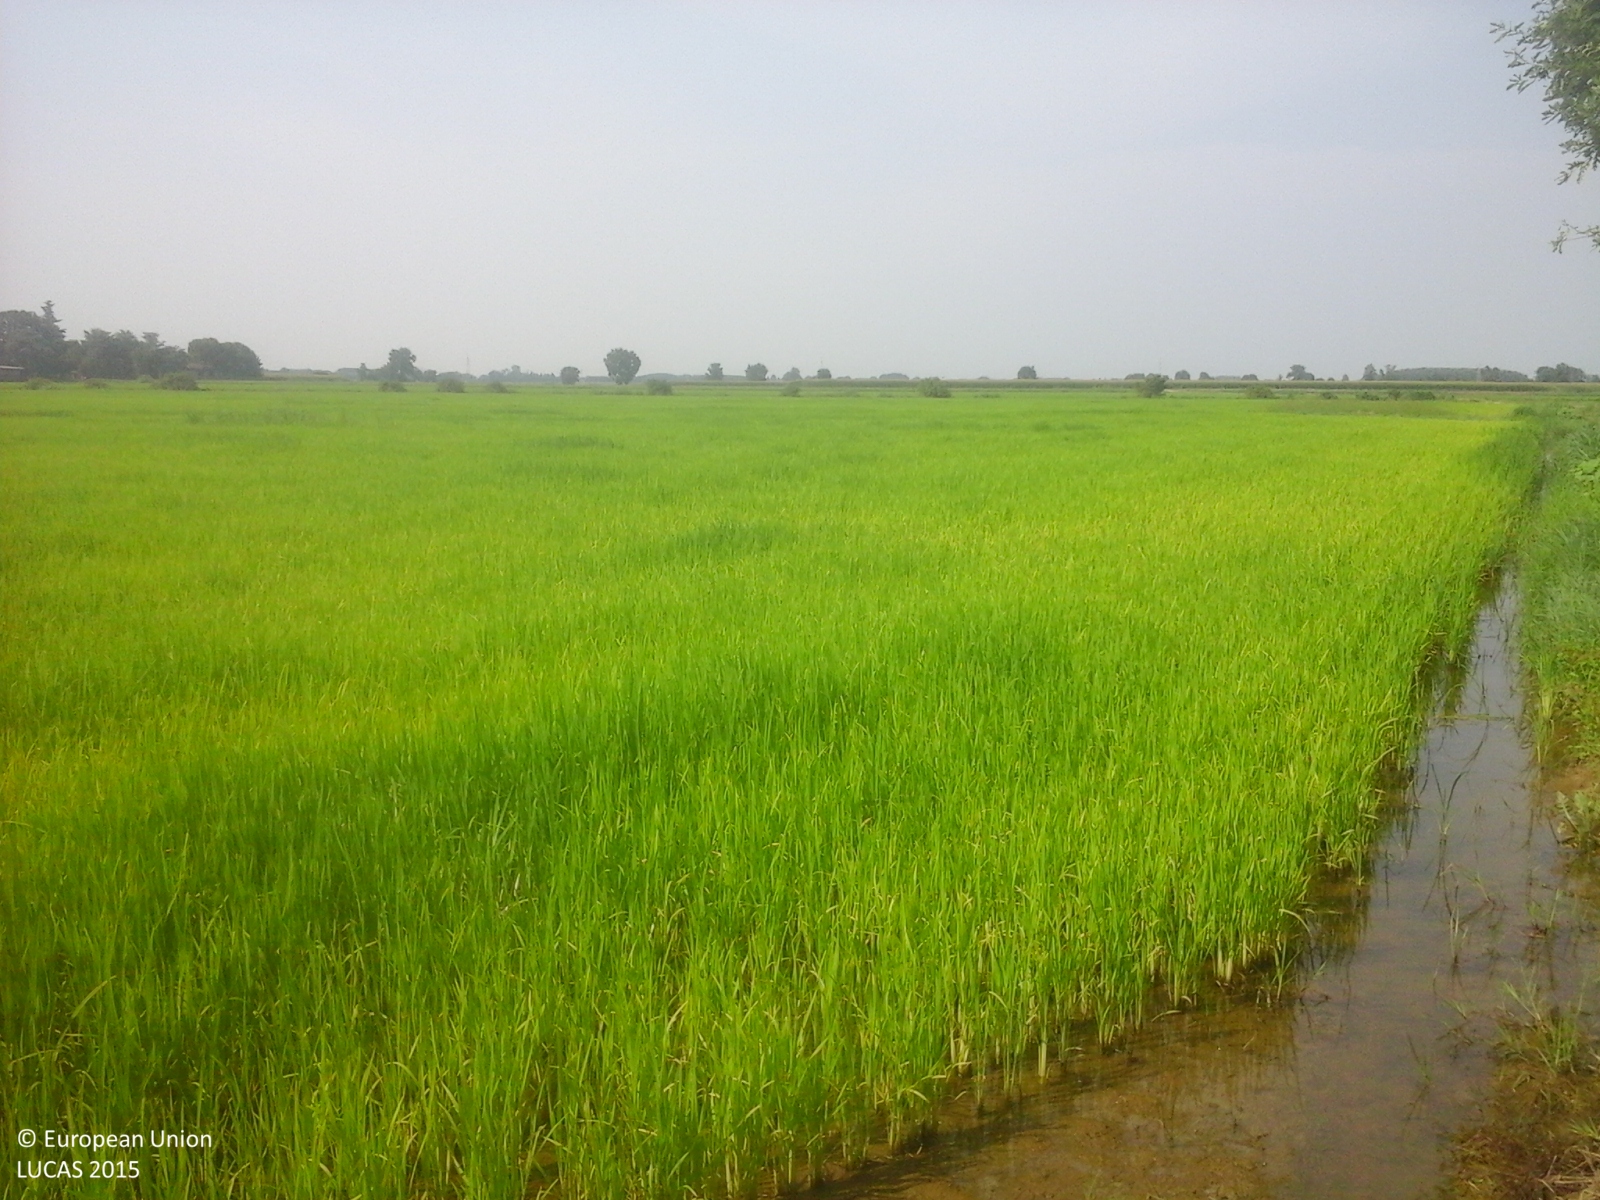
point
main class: Cropland
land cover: Rice
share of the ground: > 75 %
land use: Agriculture (excluding fallow land and kitchen gardens)
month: July
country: IT
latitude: 45.1776
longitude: 9.3014
